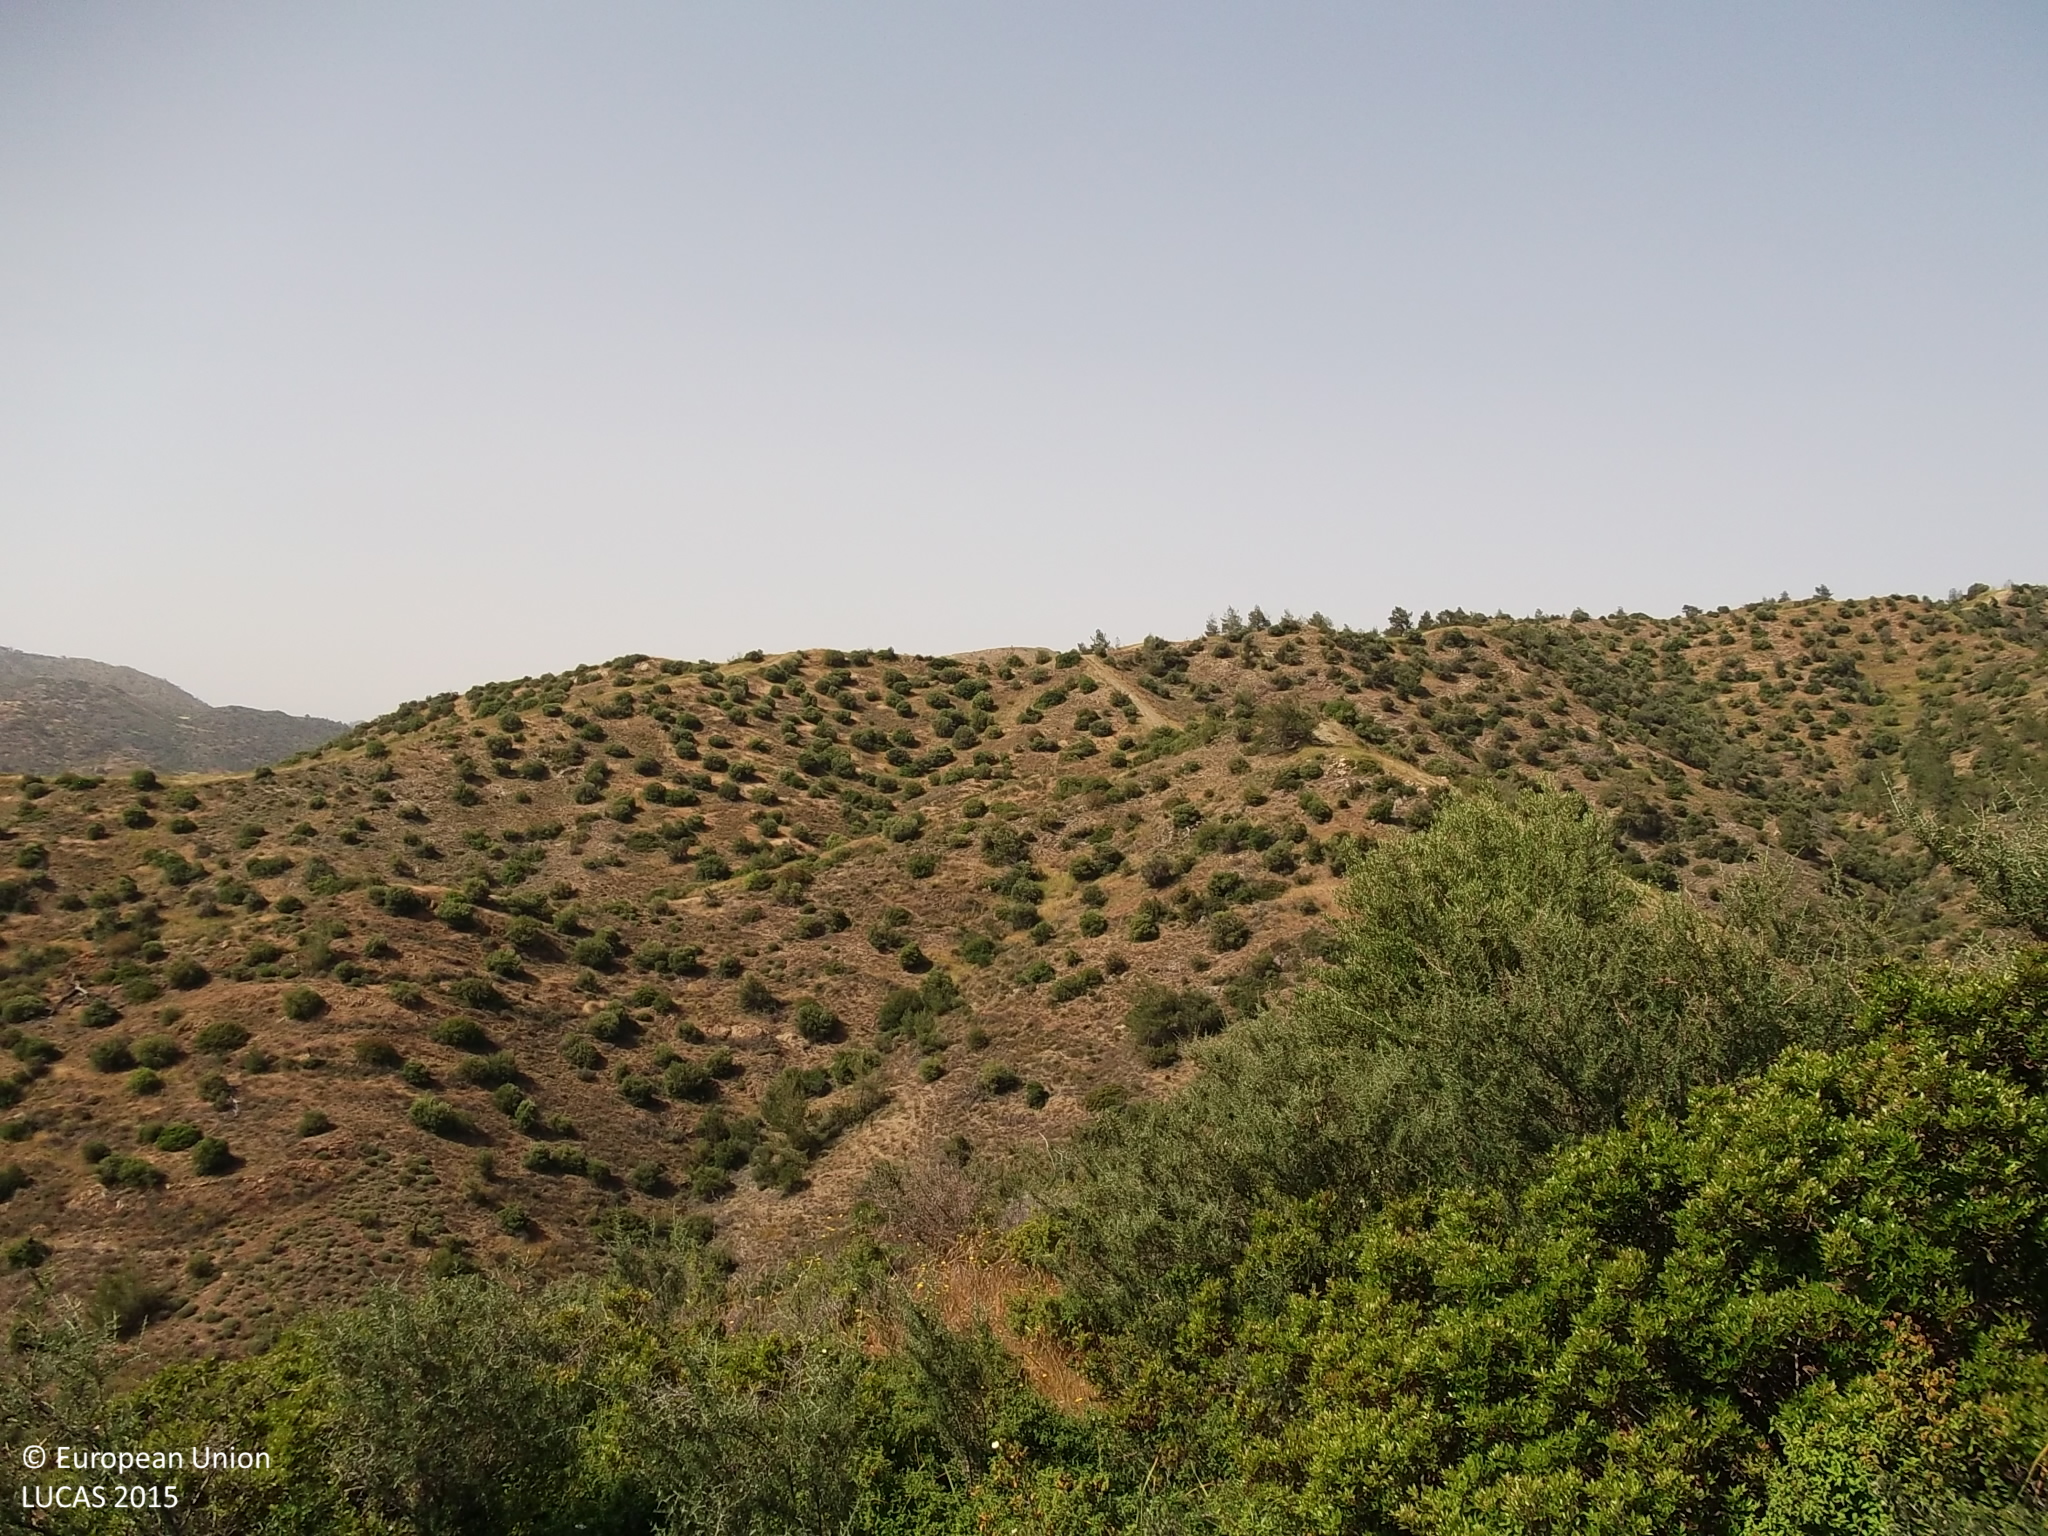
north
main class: Shrubland
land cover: Shrubland with sparse tree cover
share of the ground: > 75 %
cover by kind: shrubs 95 %, broadleaved forest trees 5 %
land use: Semi-natural and natural areas not in use
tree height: < 5 m
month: April
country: CY
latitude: 34.8744
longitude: 33.3434
